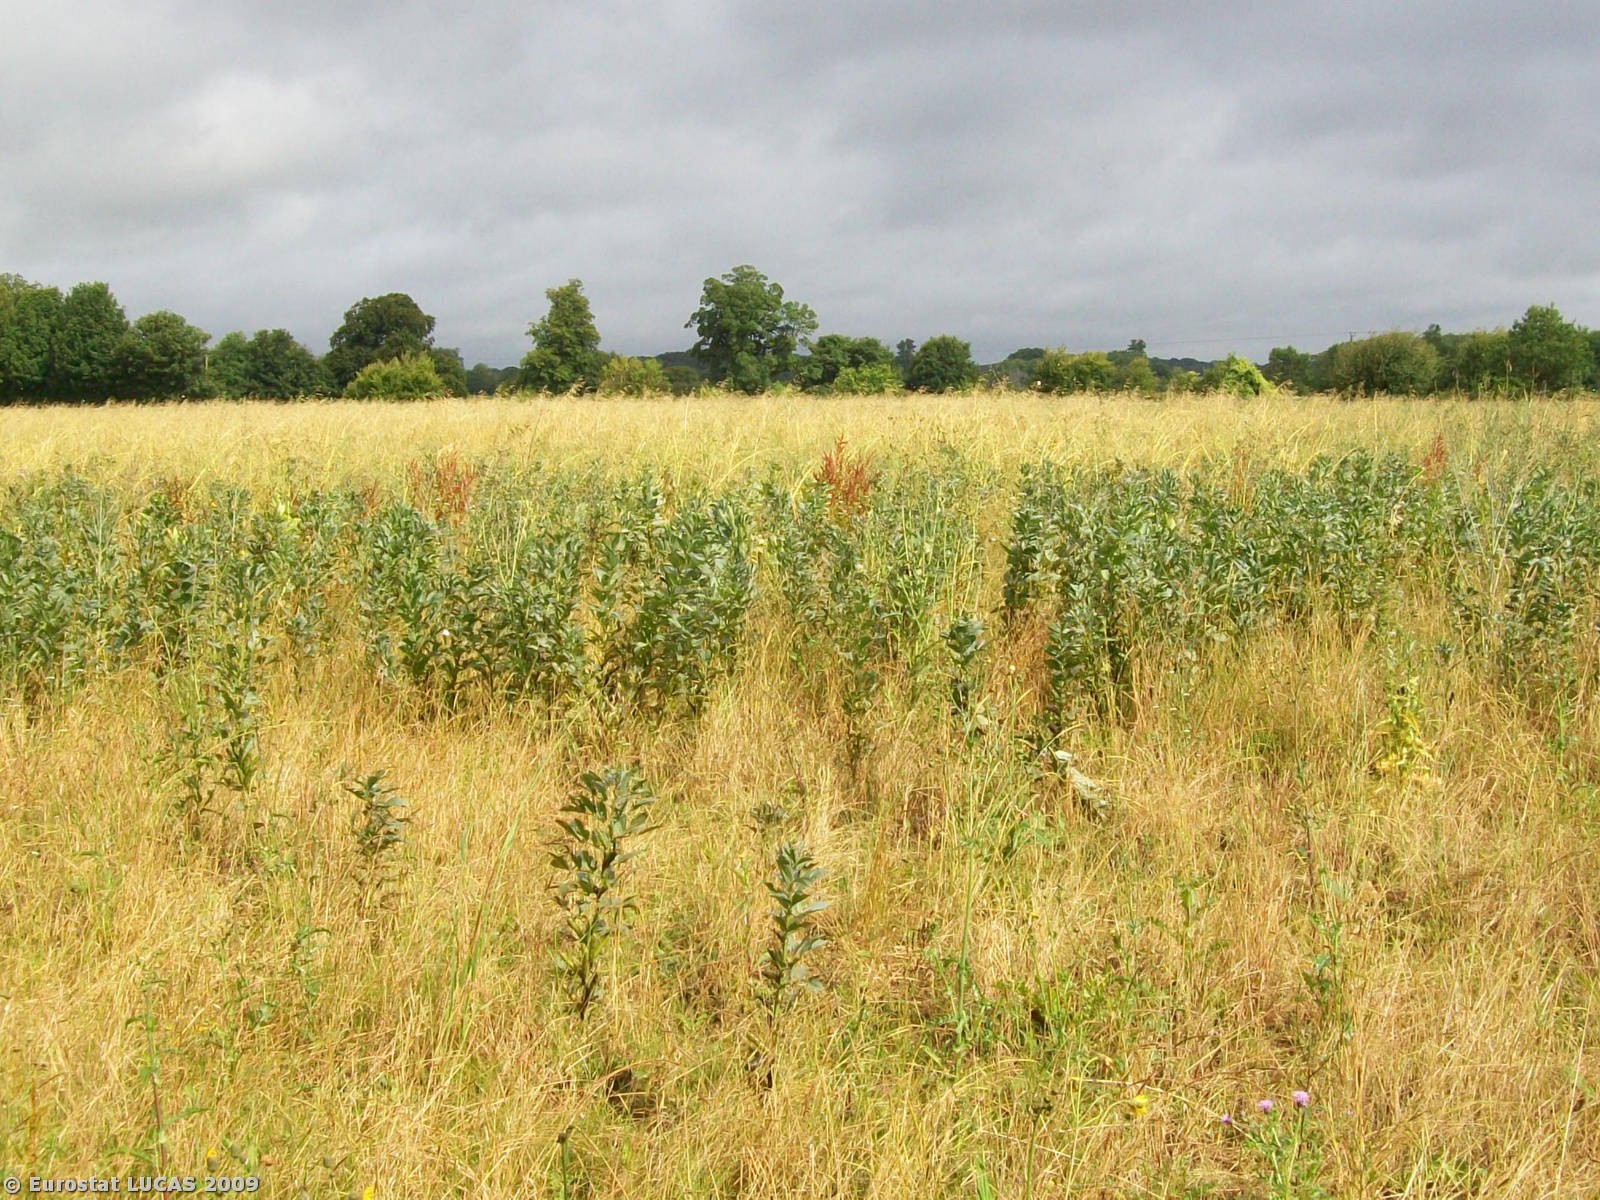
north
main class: Cropland
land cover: Dry pulses
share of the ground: > 75 %
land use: Agriculture (excluding fallow land and kitchen gardens)
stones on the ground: < 10 %
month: July
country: GB
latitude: 51.5080
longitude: -2.2077
